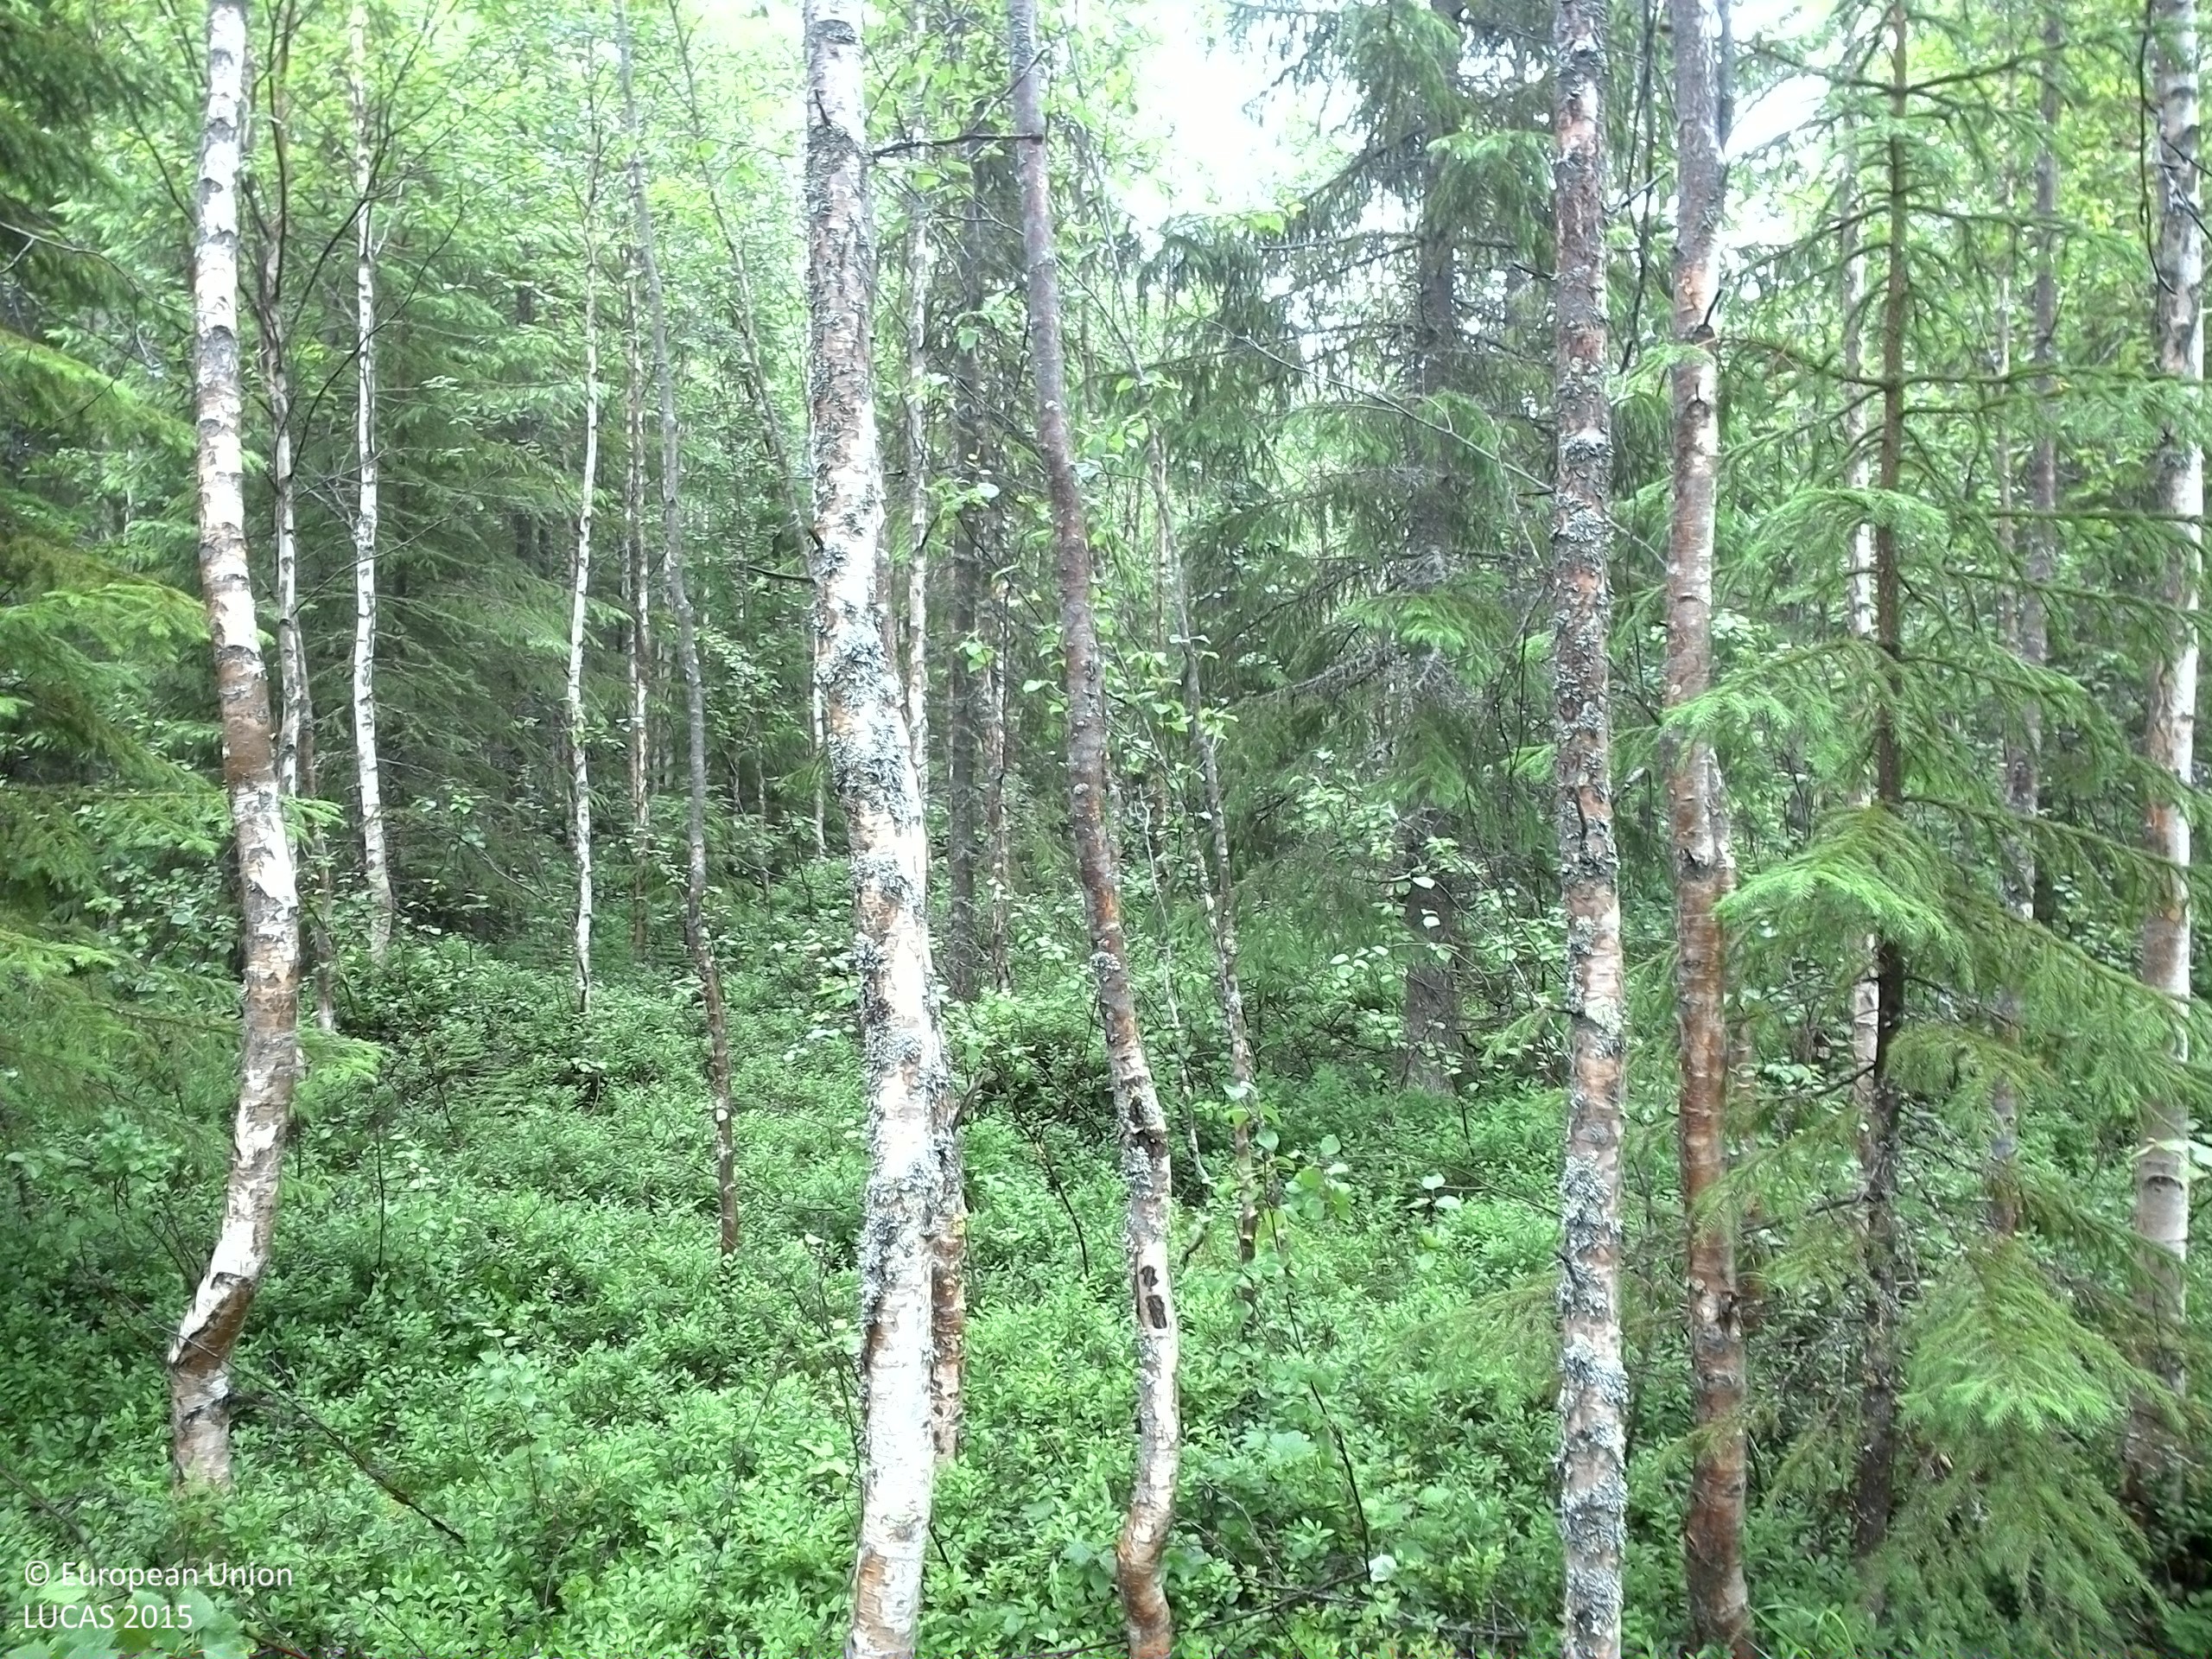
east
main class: Woodland
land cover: Spruce dominated mixed woodland
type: boreal forest
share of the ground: > 75 %
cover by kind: coniferous forest trees 45 %, broadleaved forest trees 40 %, shrubs 15 %
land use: Forestry
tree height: > 5 m
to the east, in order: Spruce dominated mixed woodland; Pine dominated coniferous woodland; Paved roads, cycling and walking lanes; Pine dominated coniferous woodland
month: July
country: SE
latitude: 62.6726
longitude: 17.2618
